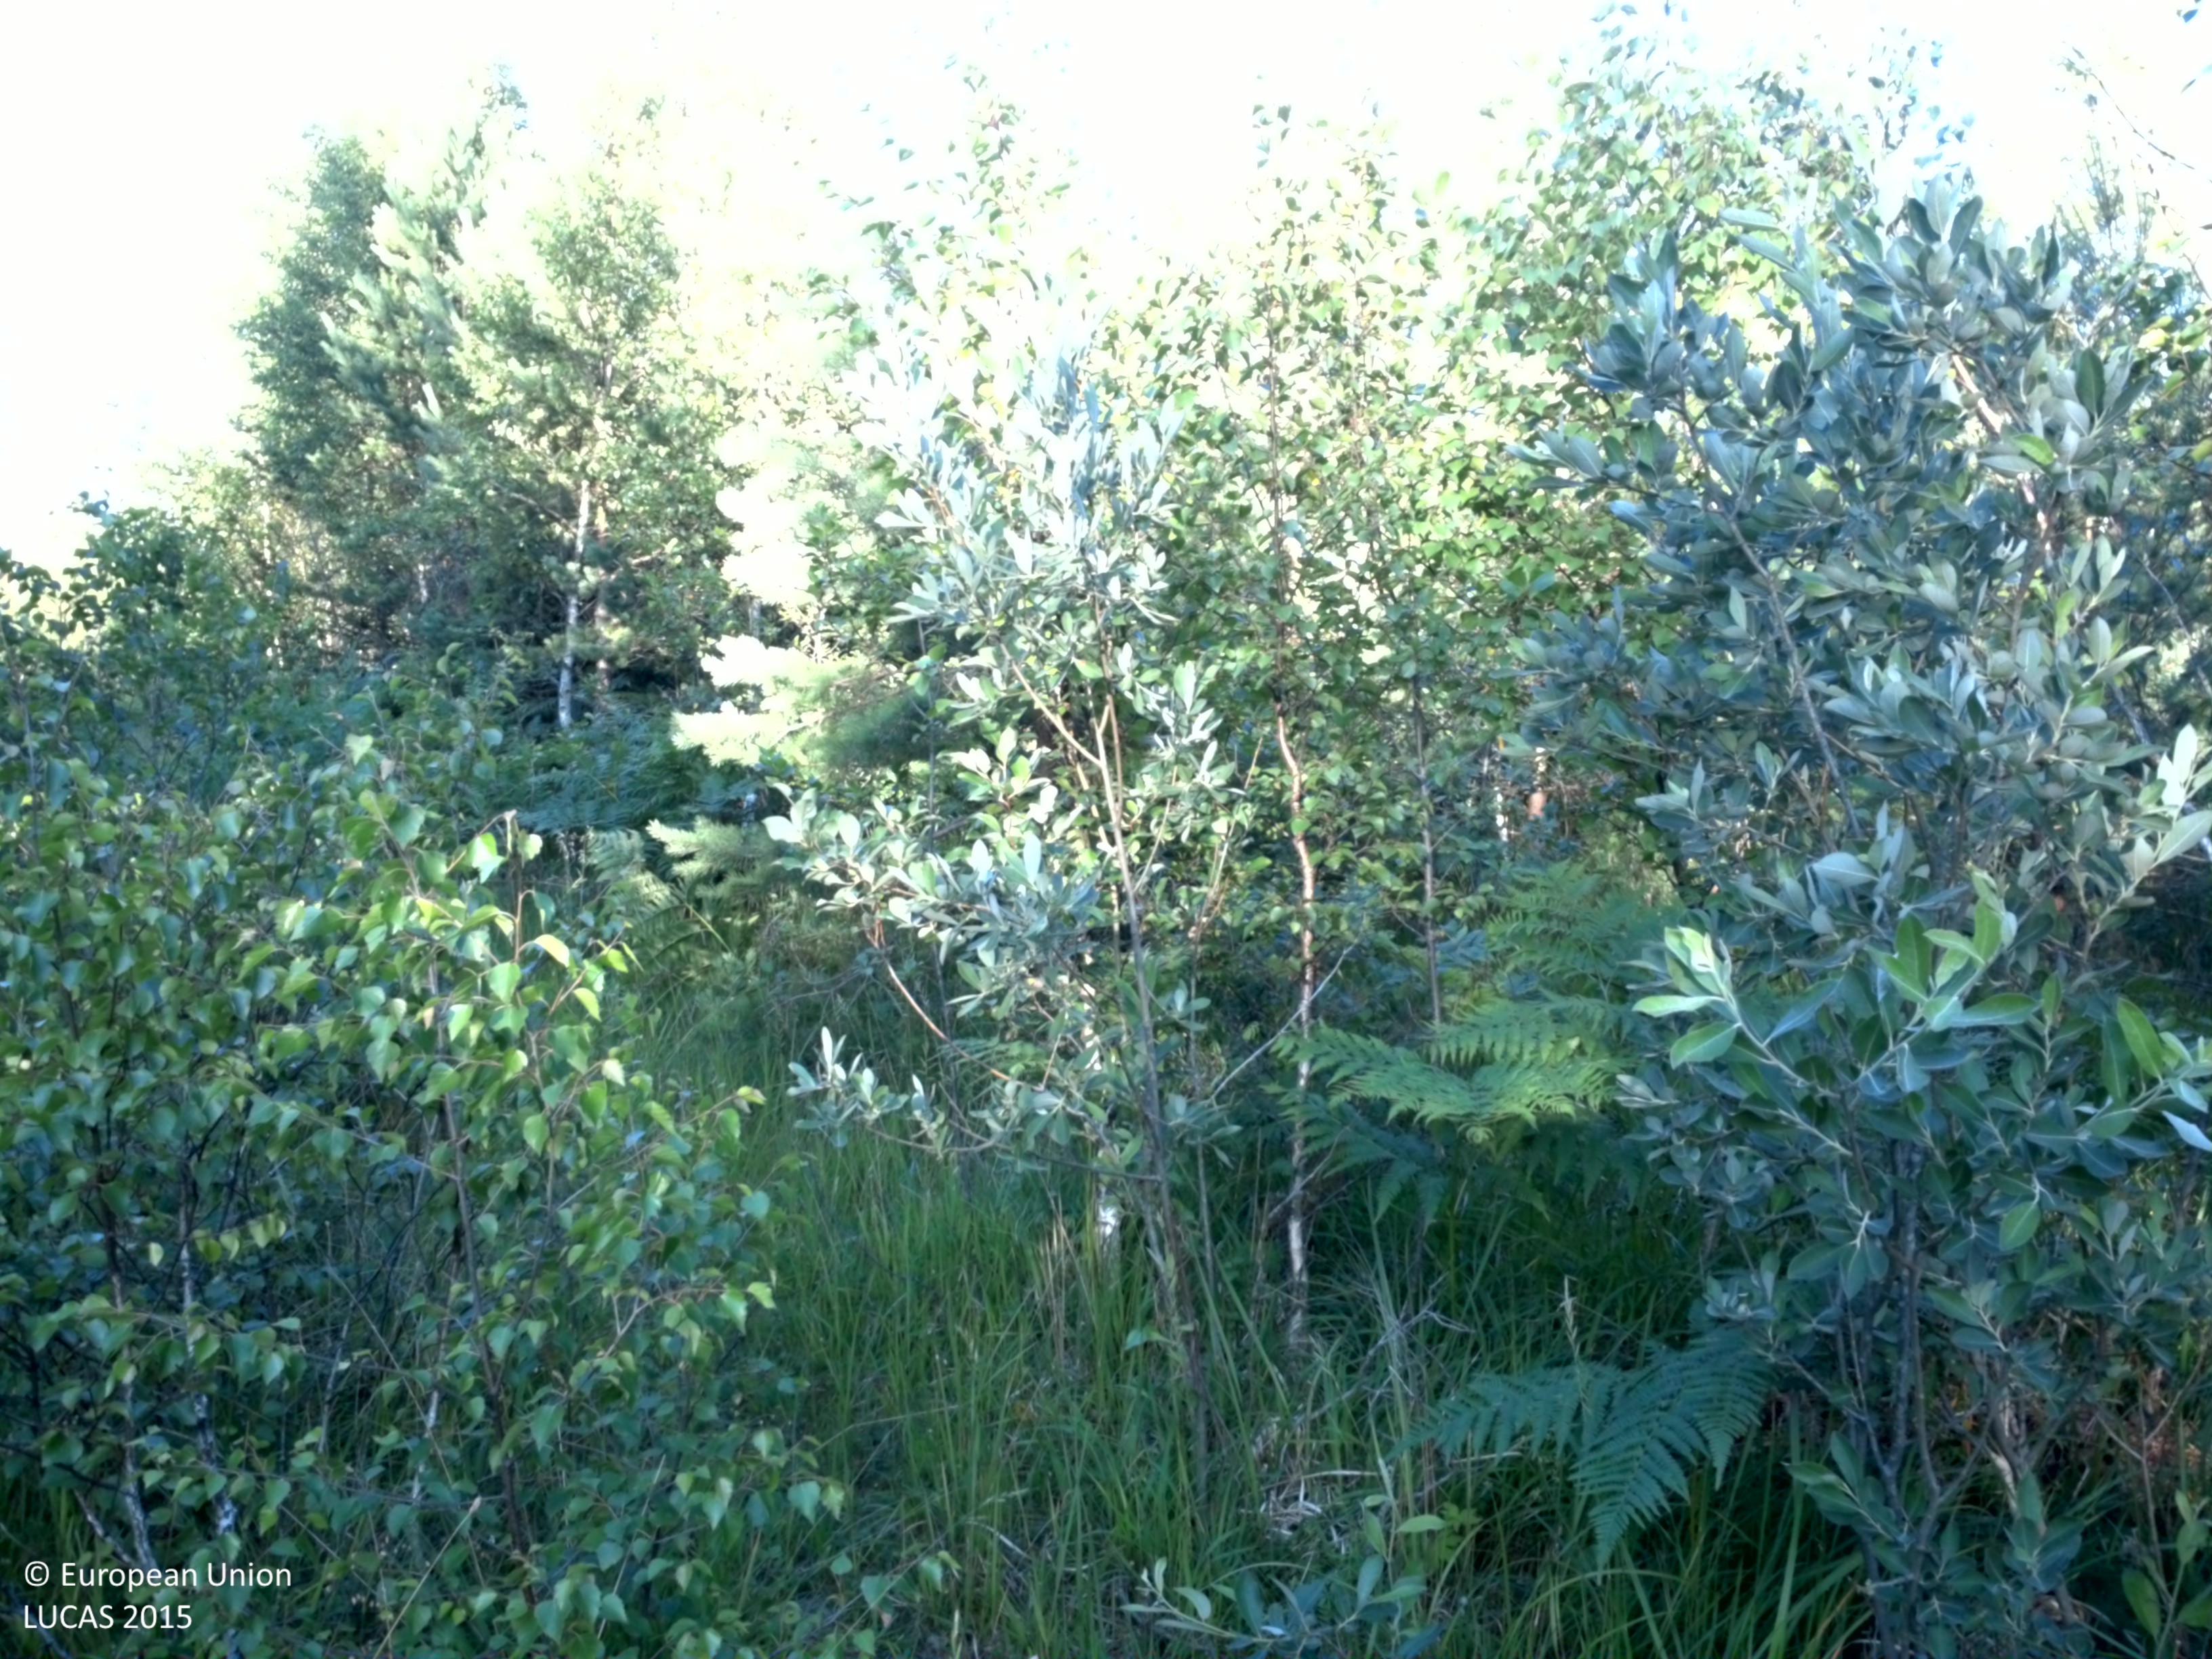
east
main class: Woodland
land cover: Other mixed woodland
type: hemiboreal forest and nemoral coniferous forest and mixed broadleaved-coniferous forest
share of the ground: > 75 %
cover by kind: broadleaved forest trees 35 %, coniferous forest trees 30 %, herbaceous plants 30 %, shrubs 5 %
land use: Forestry
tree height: < 5 m
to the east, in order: Other mixed woodland; Pine dominated coniferous woodland; Tracks; Pine dominated coniferous woodland
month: July
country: SE
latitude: 57.4823
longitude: 18.7335
